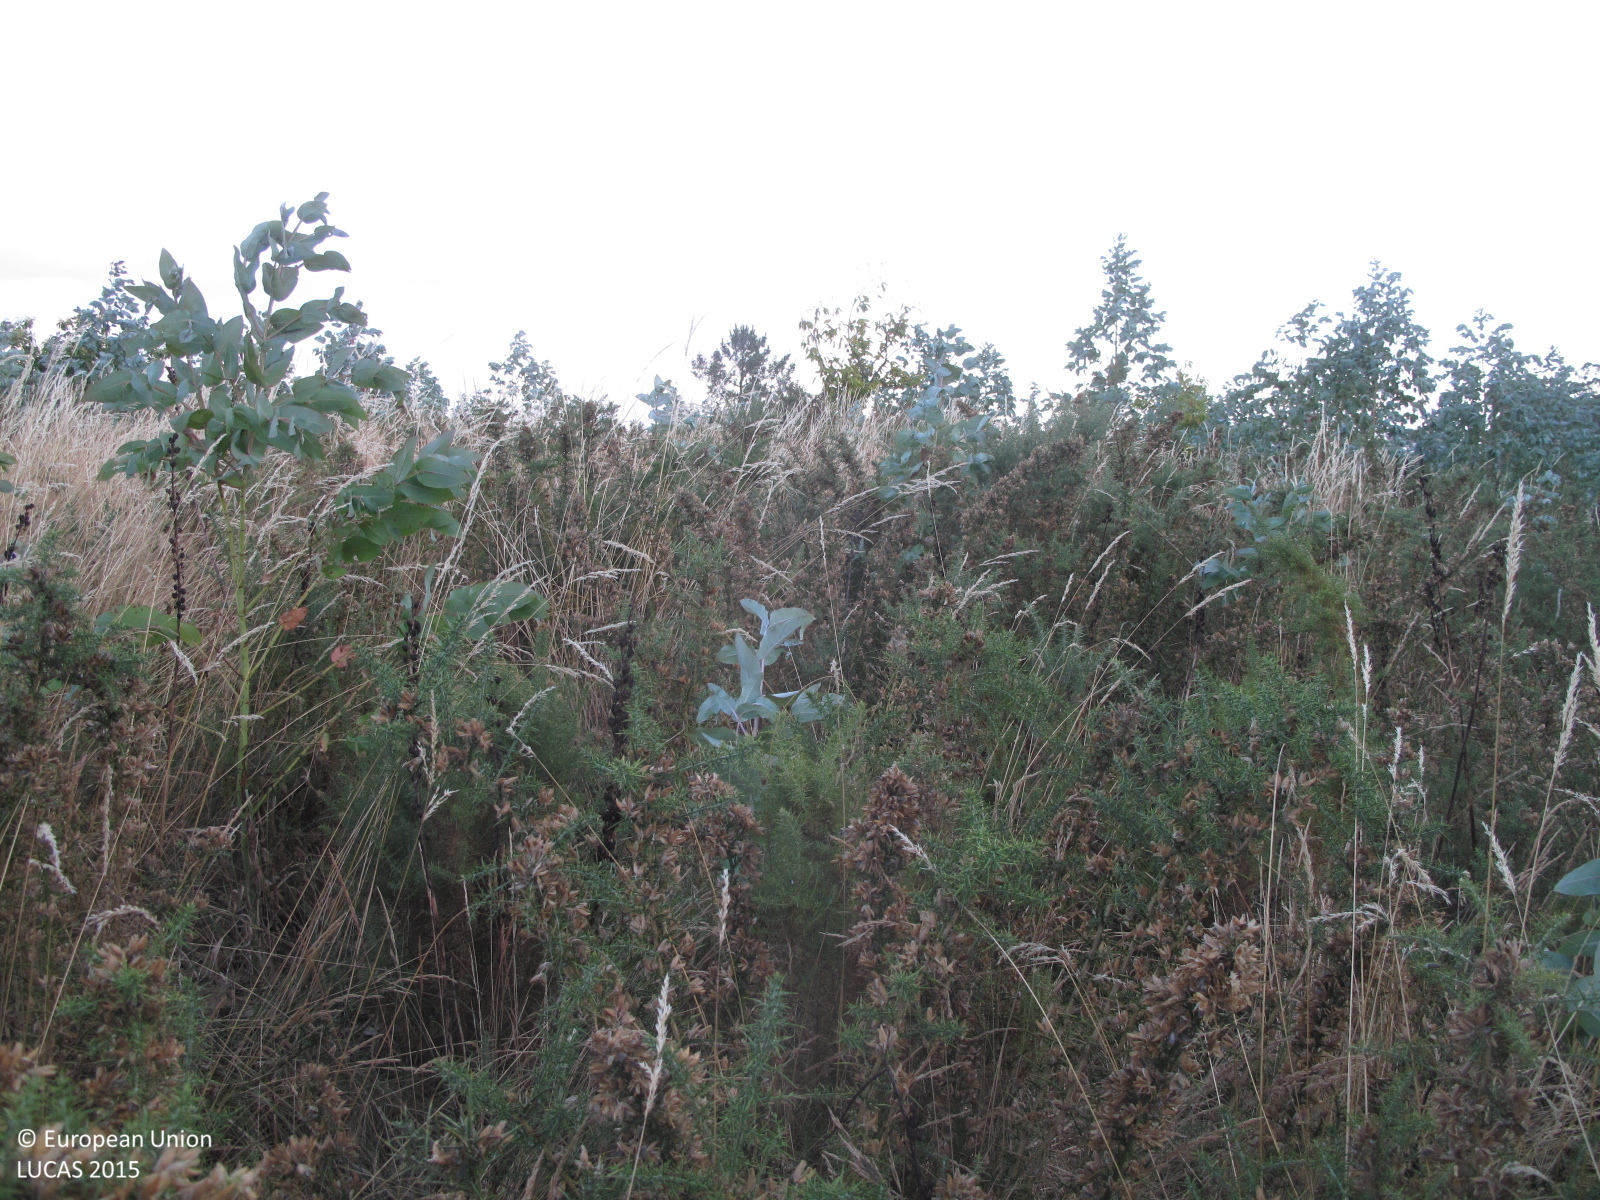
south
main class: Woodland
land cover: Broadleaved woodland
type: exotic forest
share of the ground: 10 - 25 %
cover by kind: shrubs 60 %, broadleaved forest trees 20 %, herbaceous plants 20 %
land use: Forestry
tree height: < 5 m
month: July
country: ES
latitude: 43.5524
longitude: -8.1103
